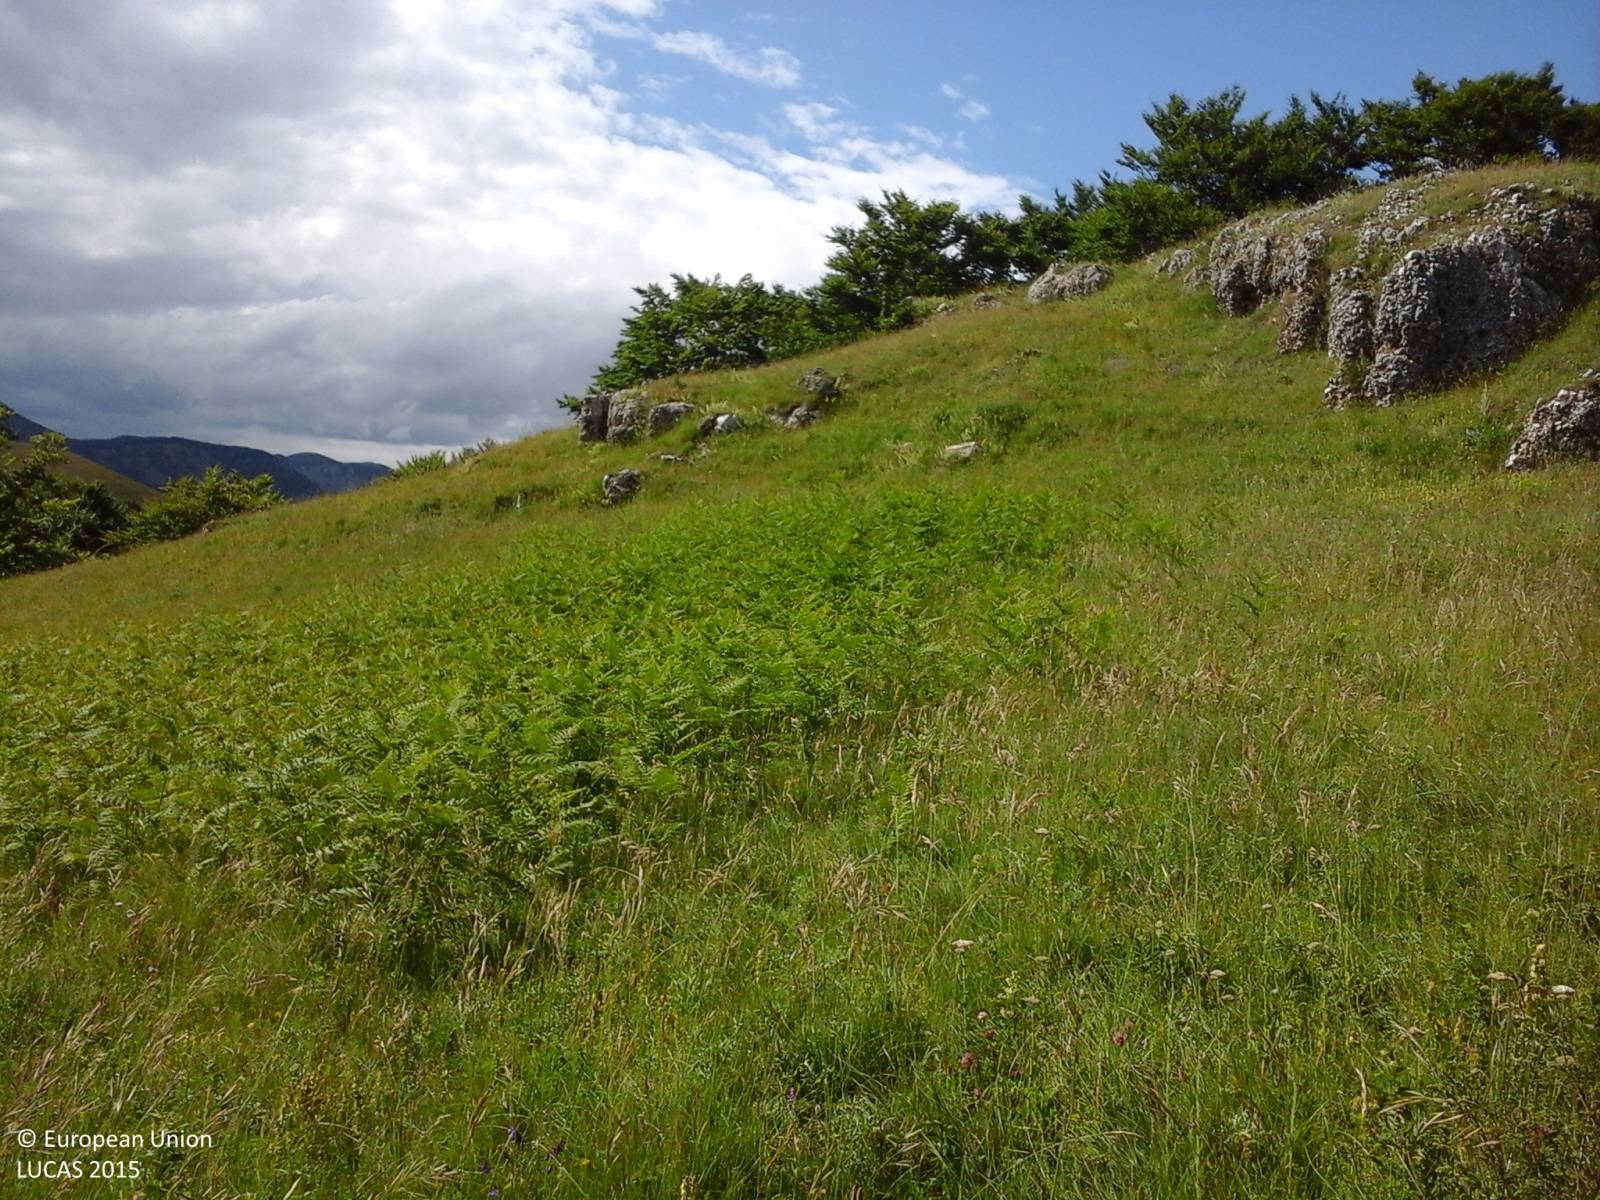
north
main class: Grassland
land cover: Grassland without tree/shrub cover
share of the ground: > 75 %
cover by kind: herbaceous plants 100 %
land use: Agriculture (excluding fallow land and kitchen gardens)
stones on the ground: 25 - 50 %
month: June
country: IT
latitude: 41.4016
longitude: 14.3737
